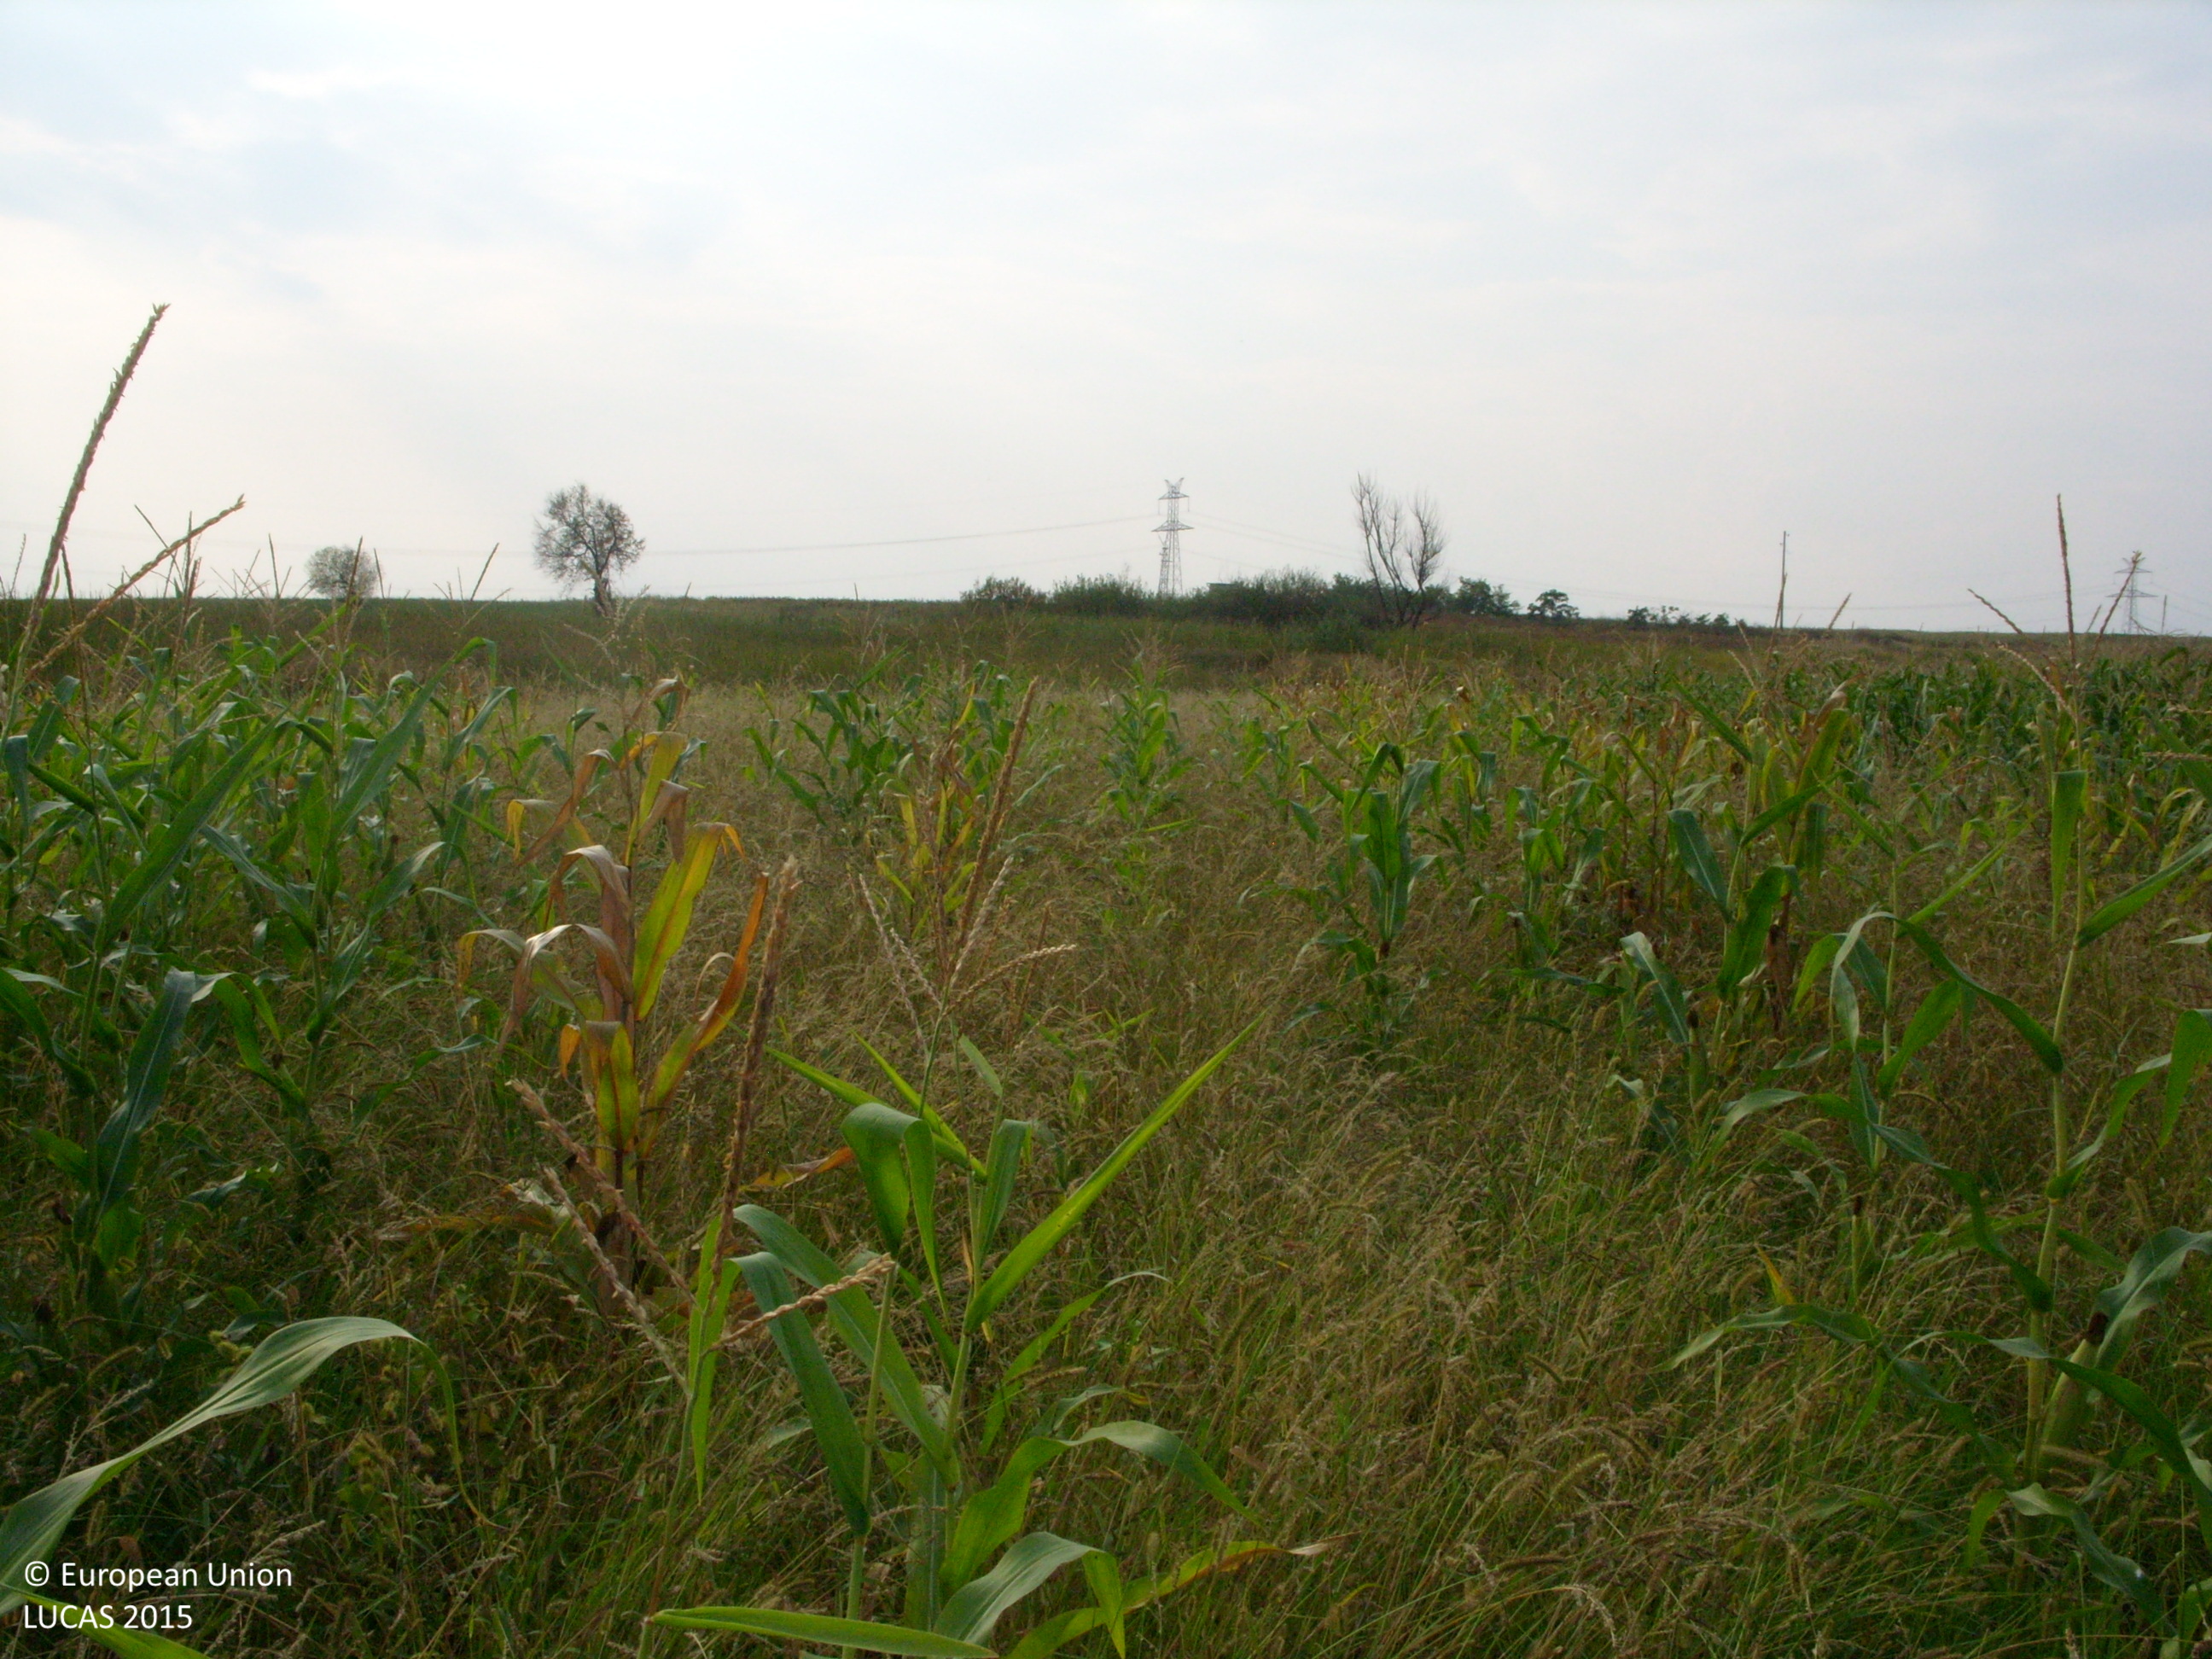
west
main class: Cropland
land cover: Maize
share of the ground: 50 - 75 %
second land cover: Spontaneously vegetated surfaces
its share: > 75 %
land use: Agriculture (excluding fallow land and kitchen gardens)
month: September
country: BG
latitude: 42.4252
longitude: 24.7737
